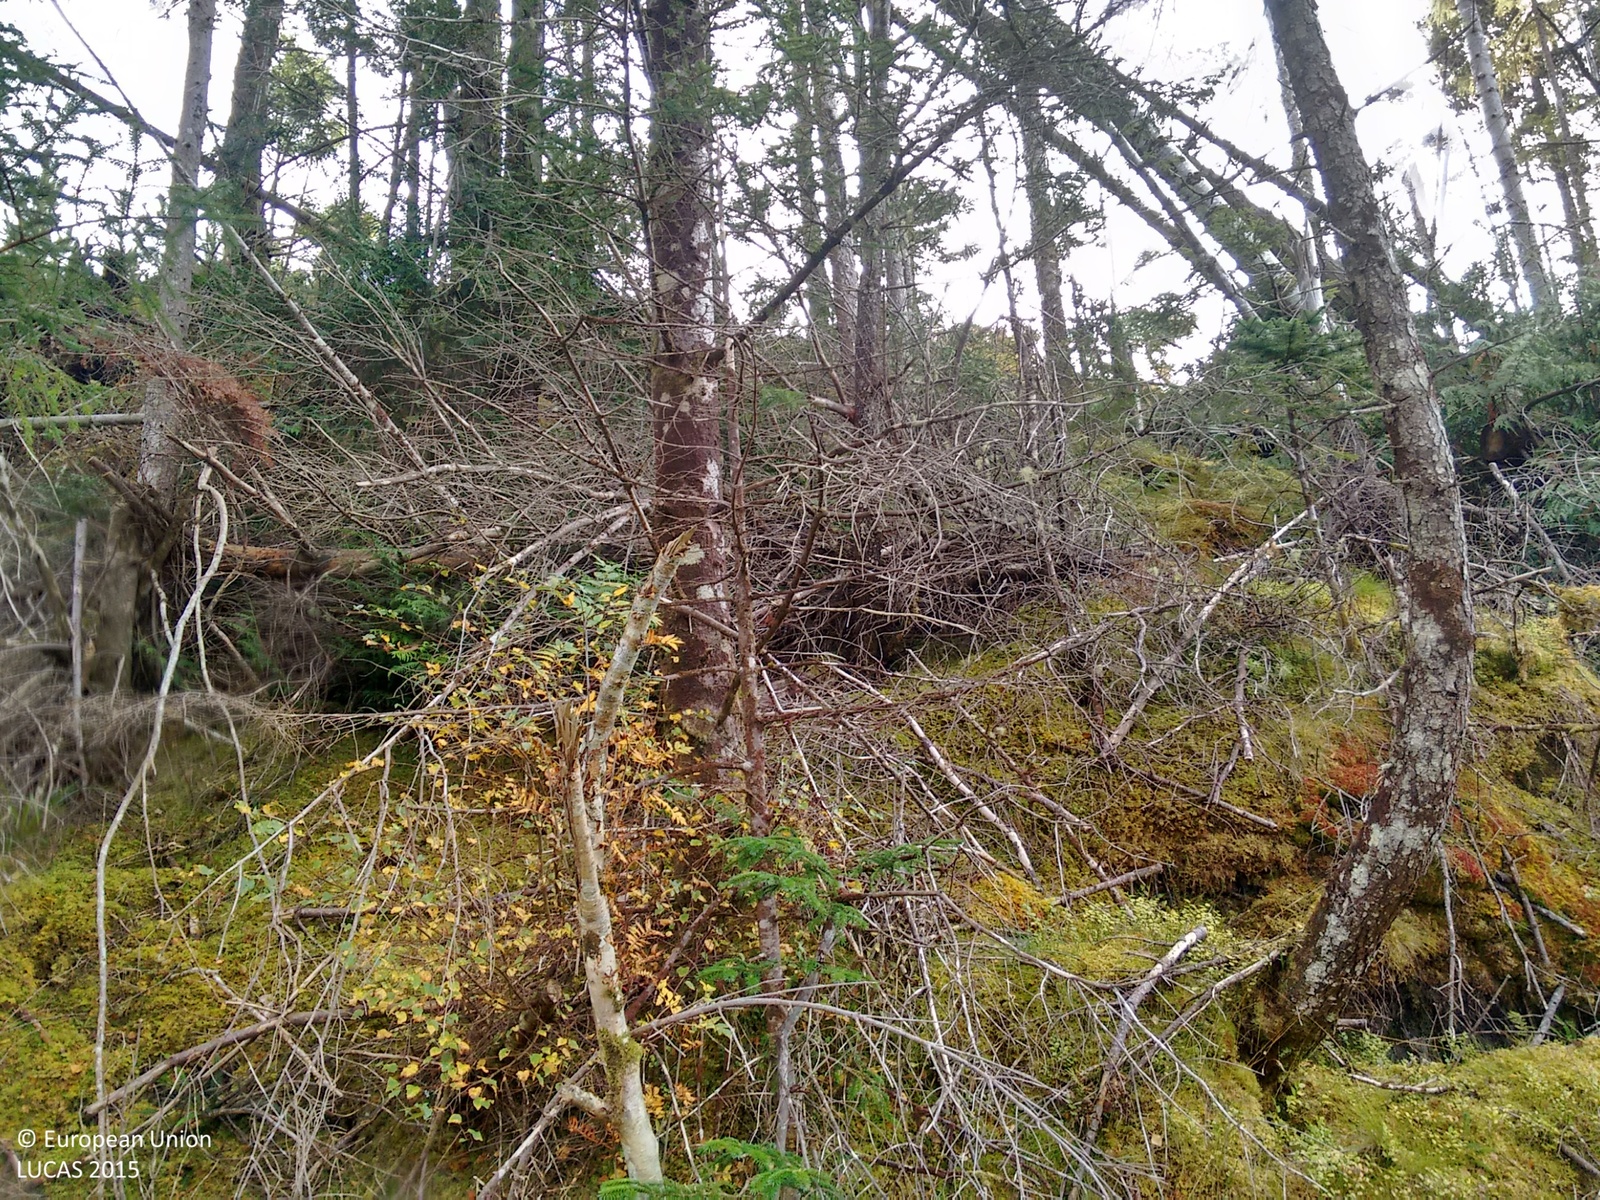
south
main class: Woodland
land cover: Spruce dominated coniferous woodland
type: exotic forest
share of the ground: > 75 %
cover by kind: coniferous forest trees 80 %, shrubs 10 %, herbaceous plants 10 %
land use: Forestry
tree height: > 5 m
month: November
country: GB
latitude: 57.3306
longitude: -5.6506
